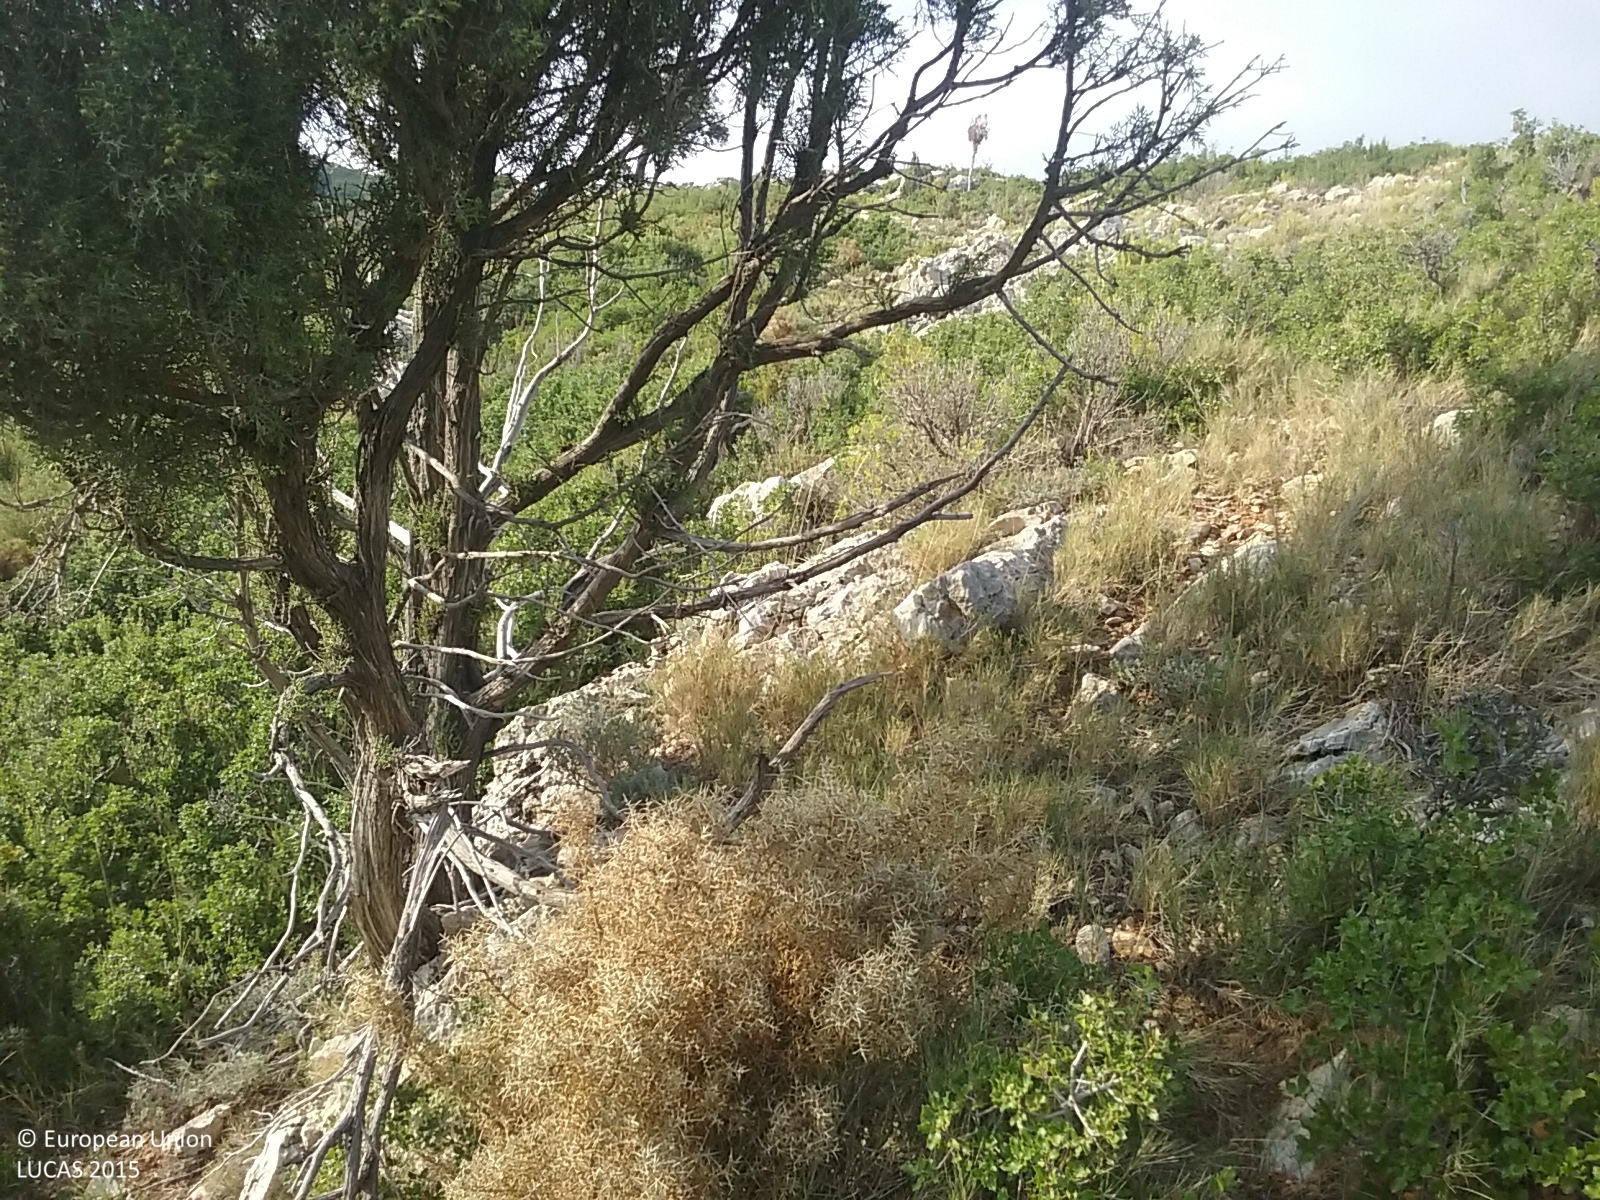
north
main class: Shrubland
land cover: Shrubland with sparse tree cover
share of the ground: > 75 %
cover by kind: shrubs 95 %, coniferous forest trees 5 %
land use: Semi-natural and natural areas not in use
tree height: < 5 m
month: August
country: ES
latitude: 40.3466
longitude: -0.0942
